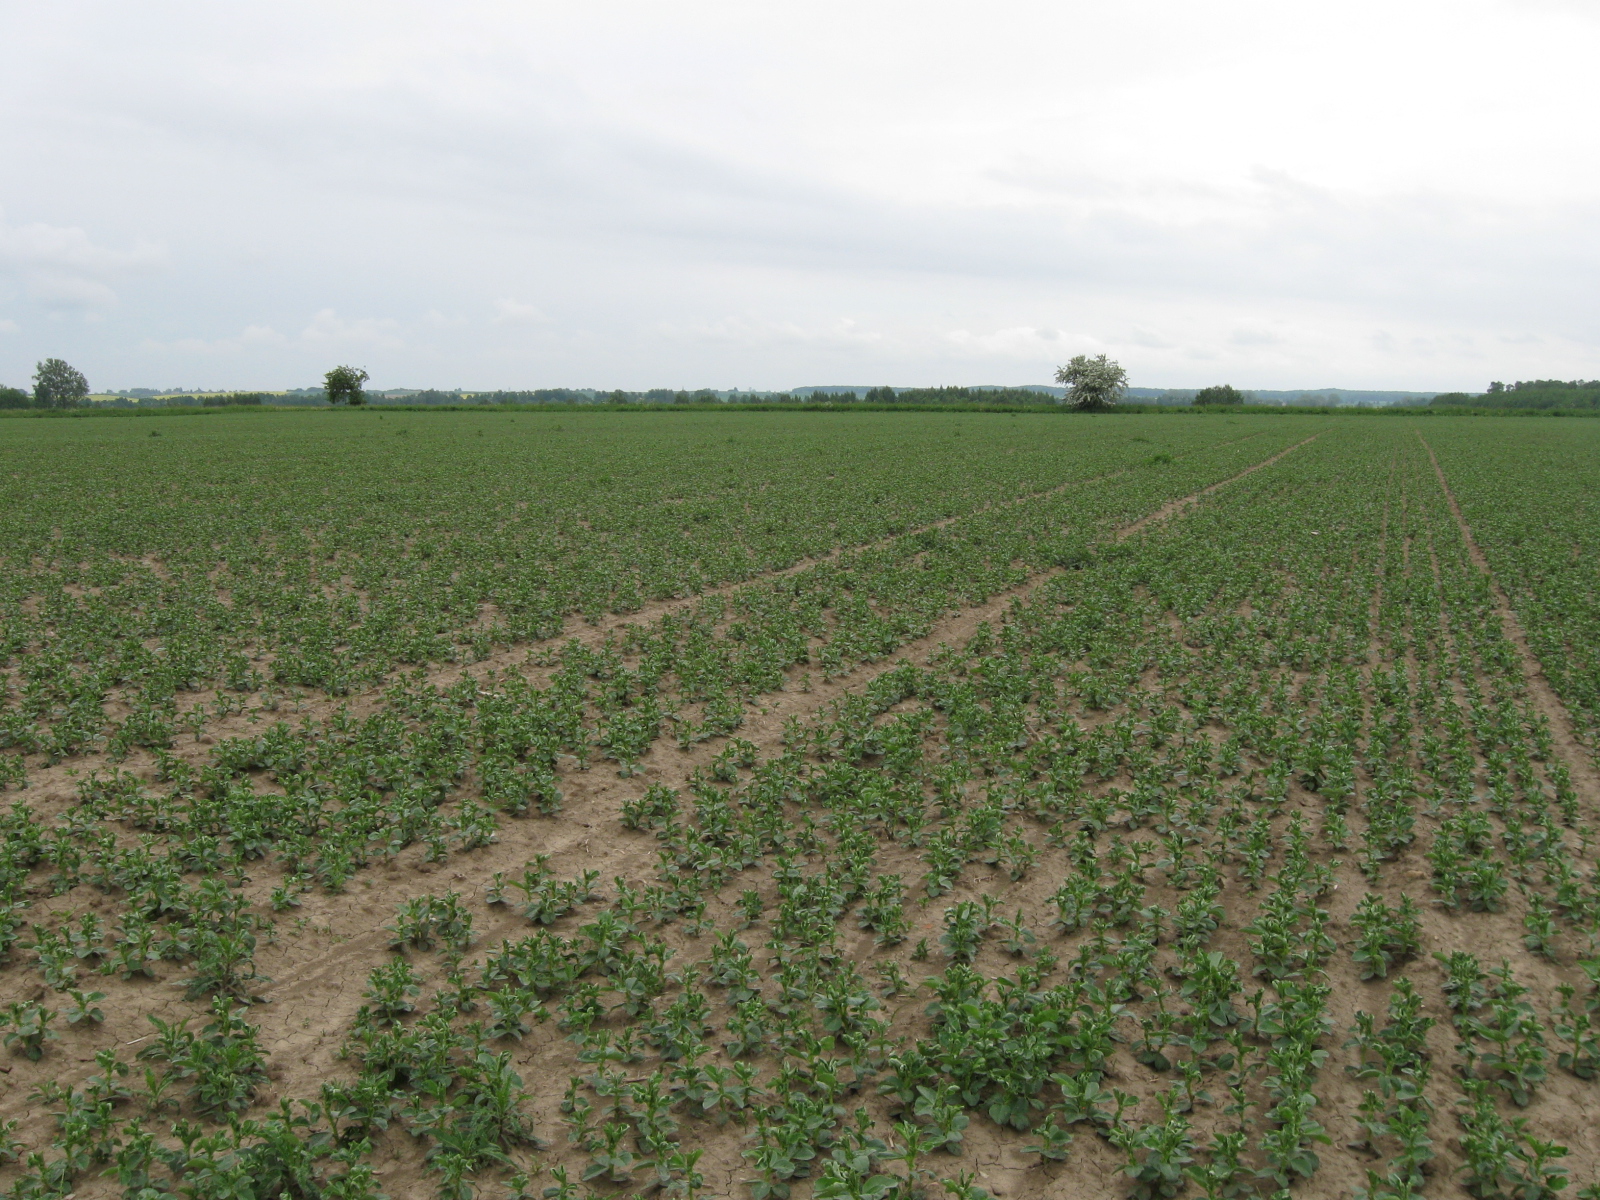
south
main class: Cropland
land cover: Dry pulses
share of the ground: 50 - 75 %
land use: Agriculture (excluding fallow land and kitchen gardens)
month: May
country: LT
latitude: 54.6446
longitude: 22.8539
